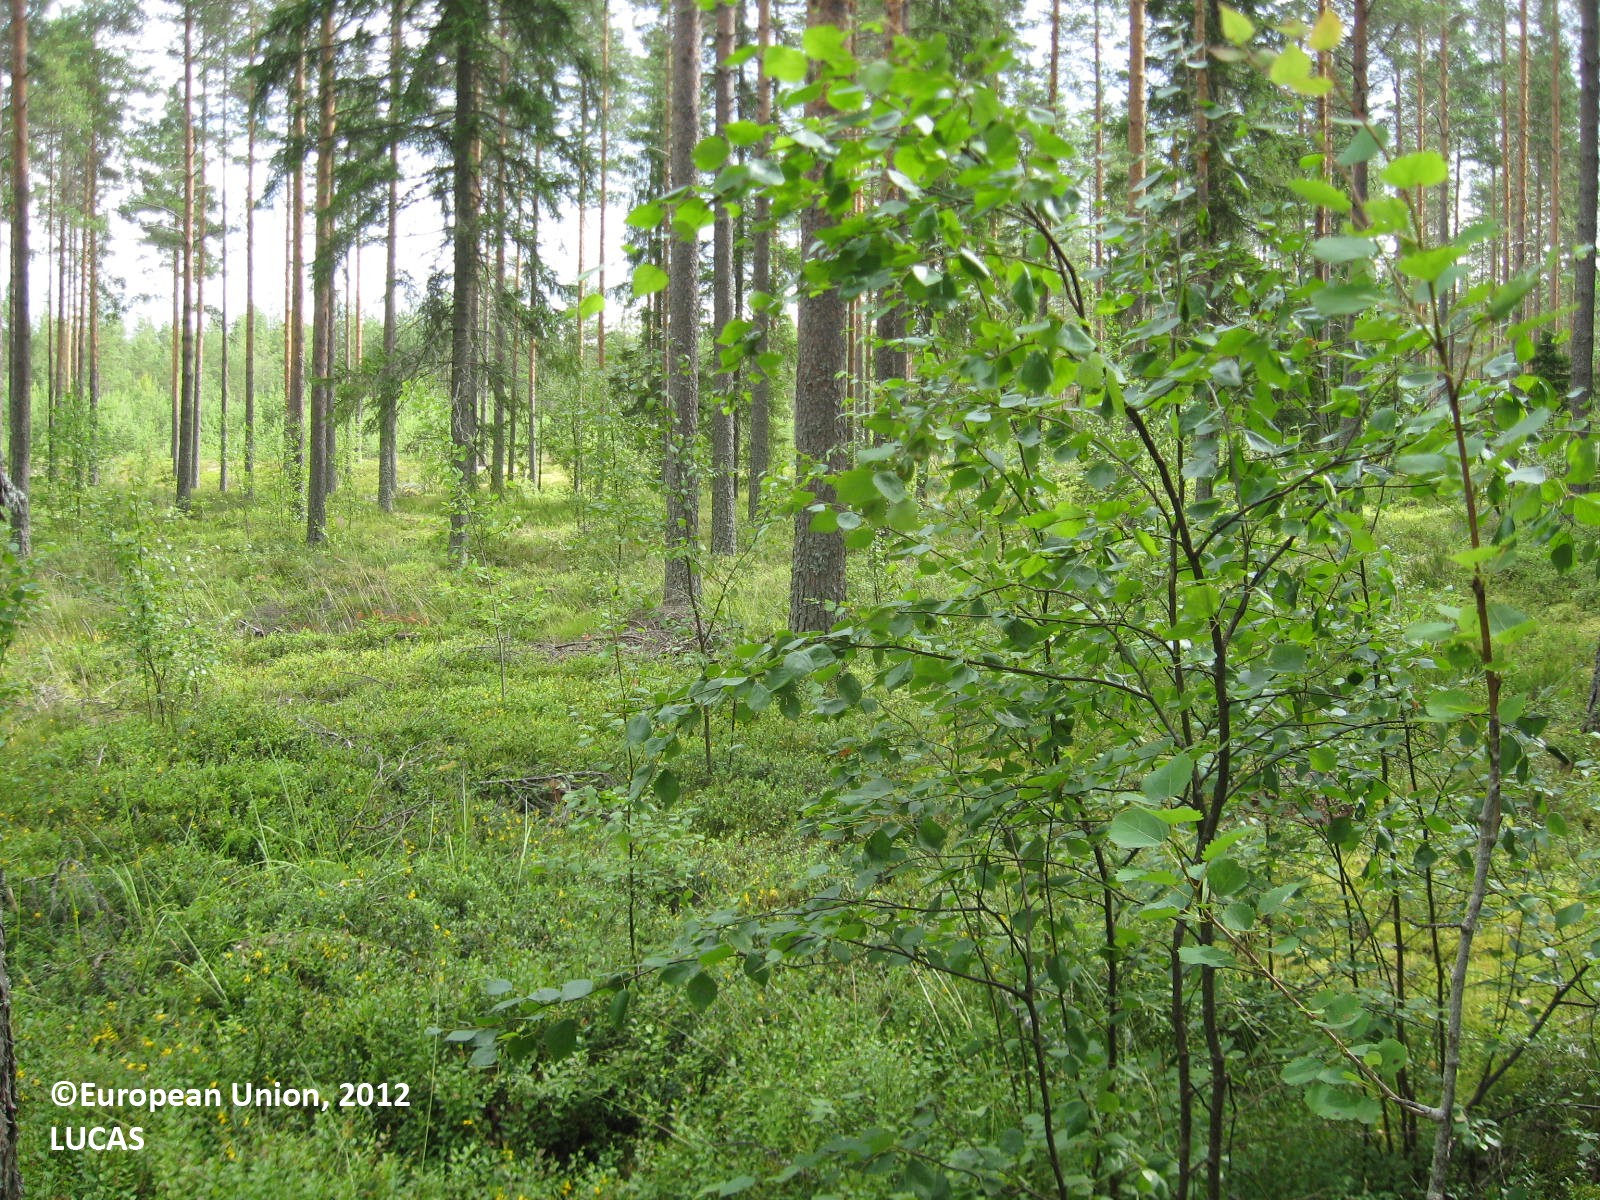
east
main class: Woodland
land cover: Pine dominated coniferous woodland
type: boreal forest
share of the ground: > 75 %
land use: Forestry
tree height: > 5 m
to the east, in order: Pine dominated coniferous woodland; Other coniferous woodland; Pine dominated coniferous woodland
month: July
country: FI
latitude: 62.1444
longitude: 22.2761
